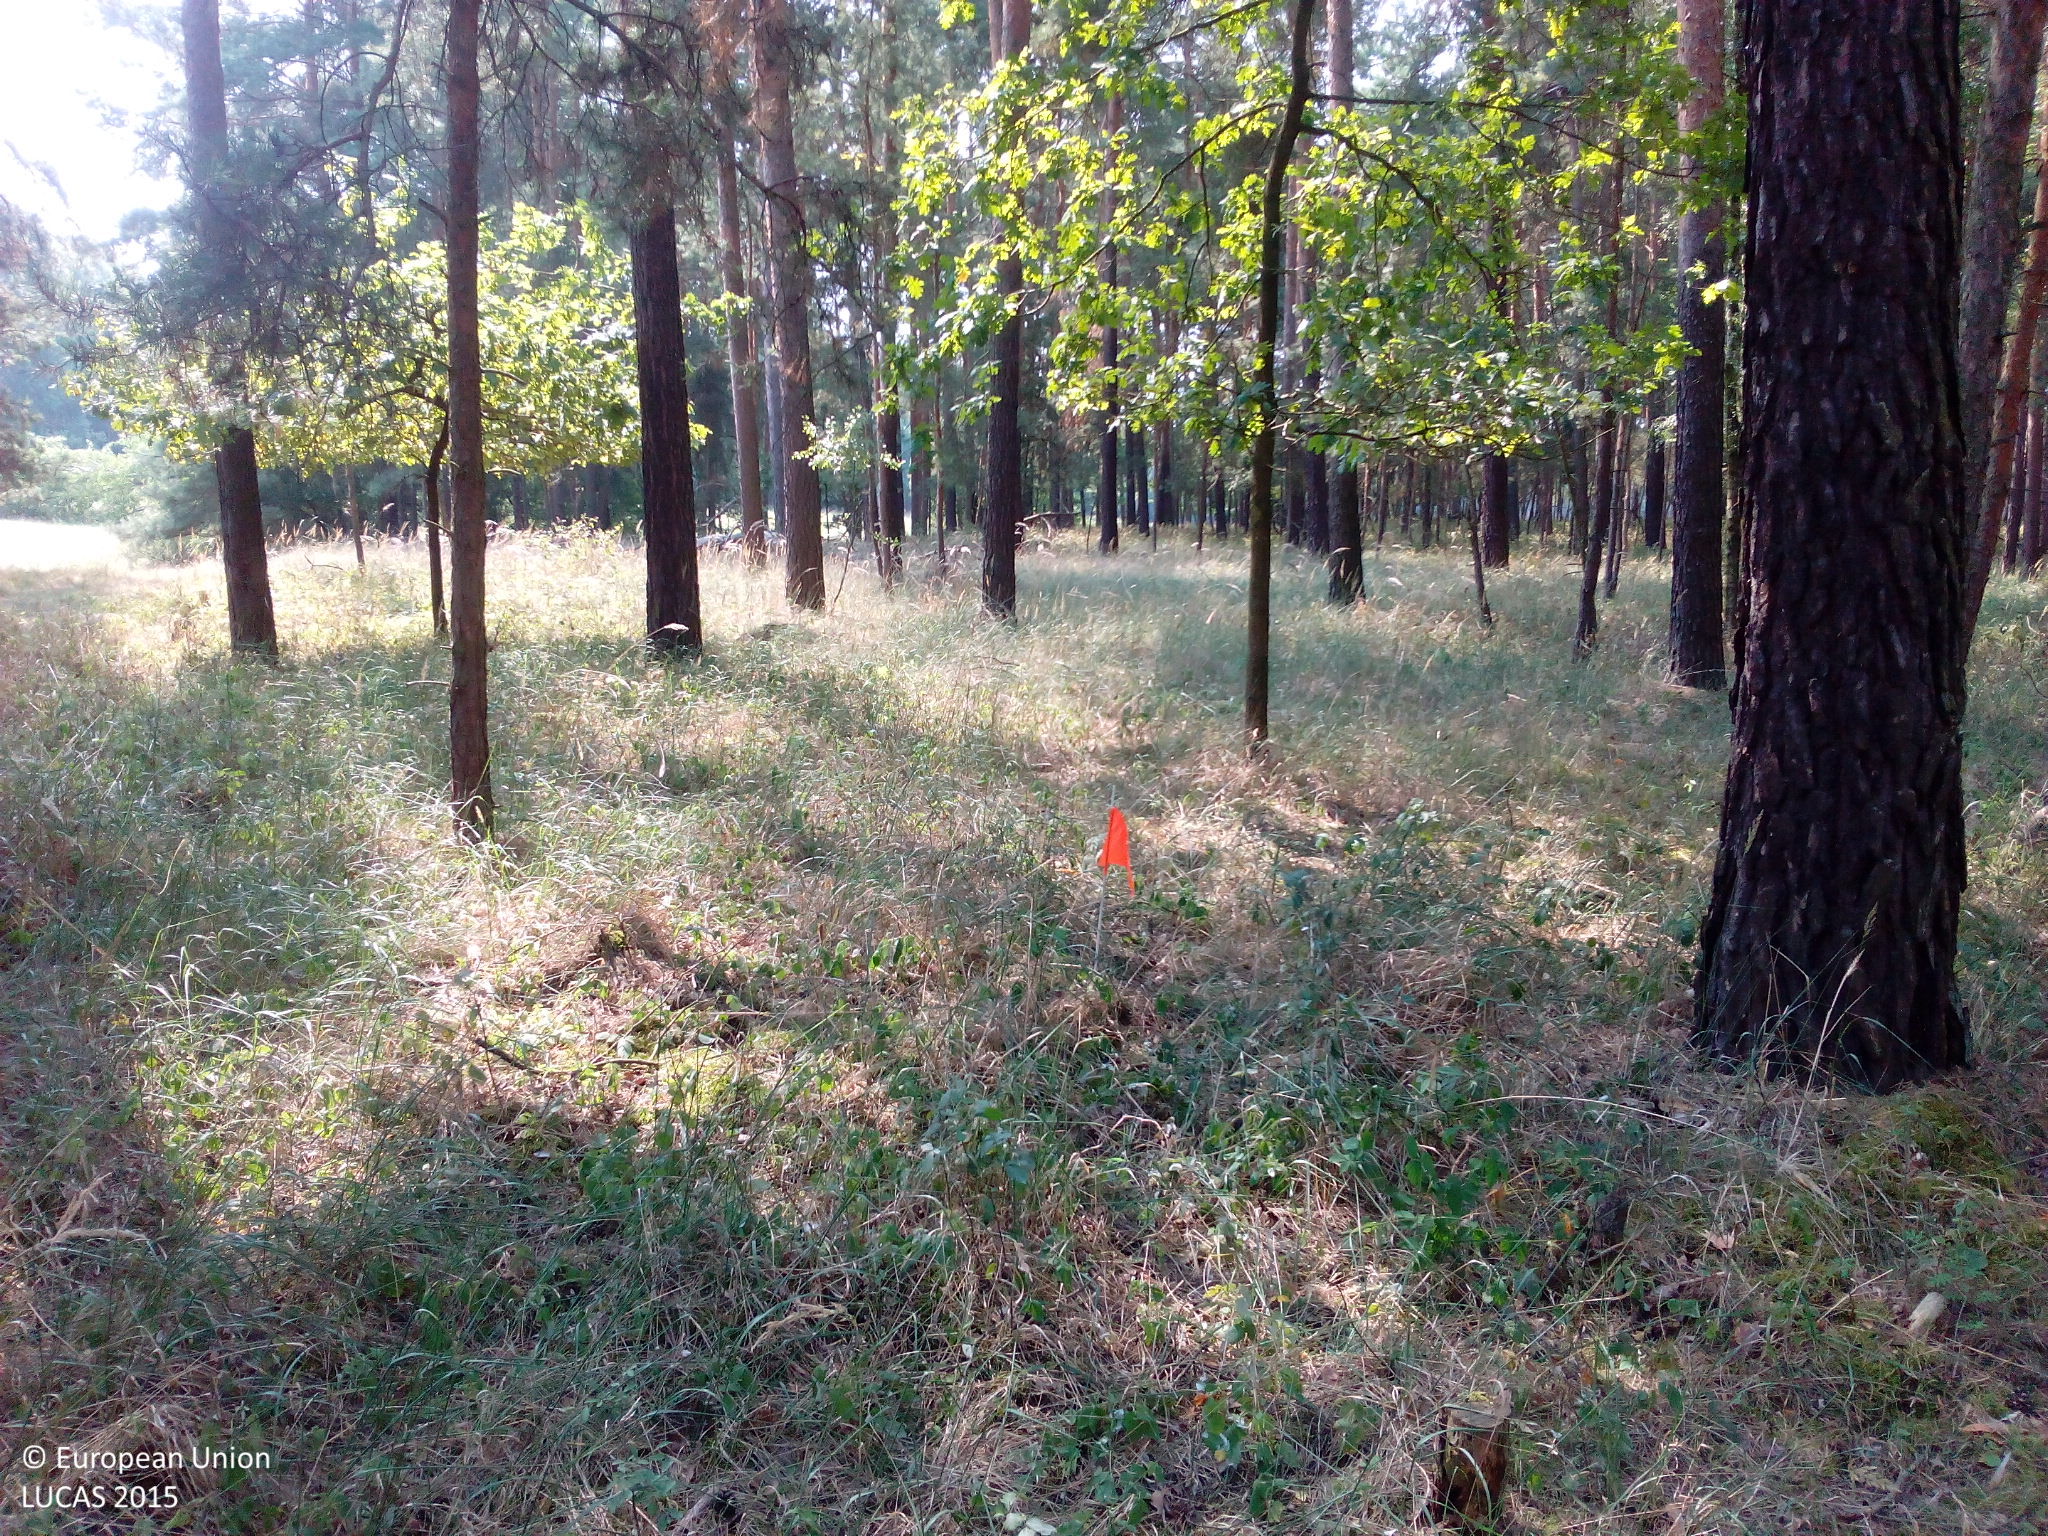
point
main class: Woodland
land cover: Pine dominated coniferous woodland
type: hemiboreal forest and nemoral coniferous forest and mixed broadleaved-coniferous forest
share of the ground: > 75 %
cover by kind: coniferous forest trees 95 %, herbaceous plants 5 %
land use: Forestry
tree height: > 5 m
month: August
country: DE
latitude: 51.7563
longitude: 12.5640
